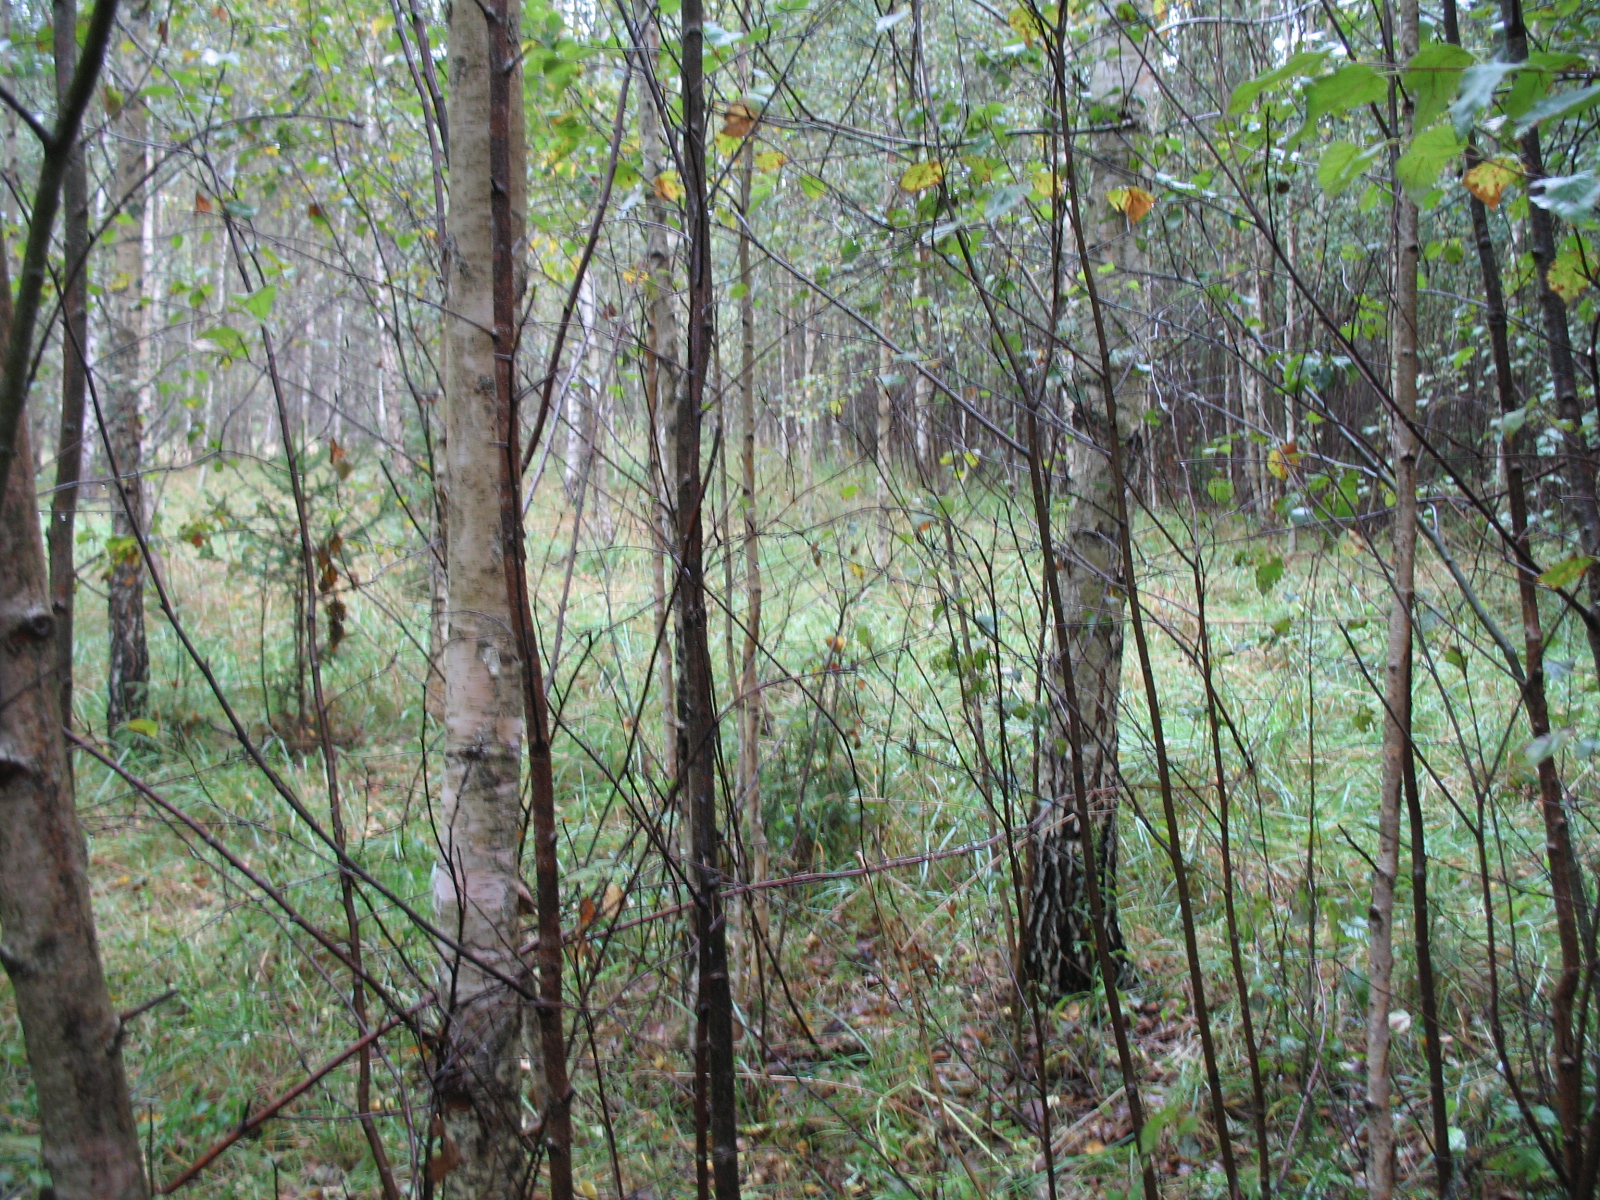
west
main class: Woodland
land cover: Broadleaved woodland
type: non-riverine alder, birch or aspen forest
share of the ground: 50 - 75 %
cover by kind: broadleaved forest trees 70 %, herbaceous plants 30 %
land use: Forestry
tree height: > 5 m
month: September
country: LV
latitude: 56.0174
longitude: 25.8693
